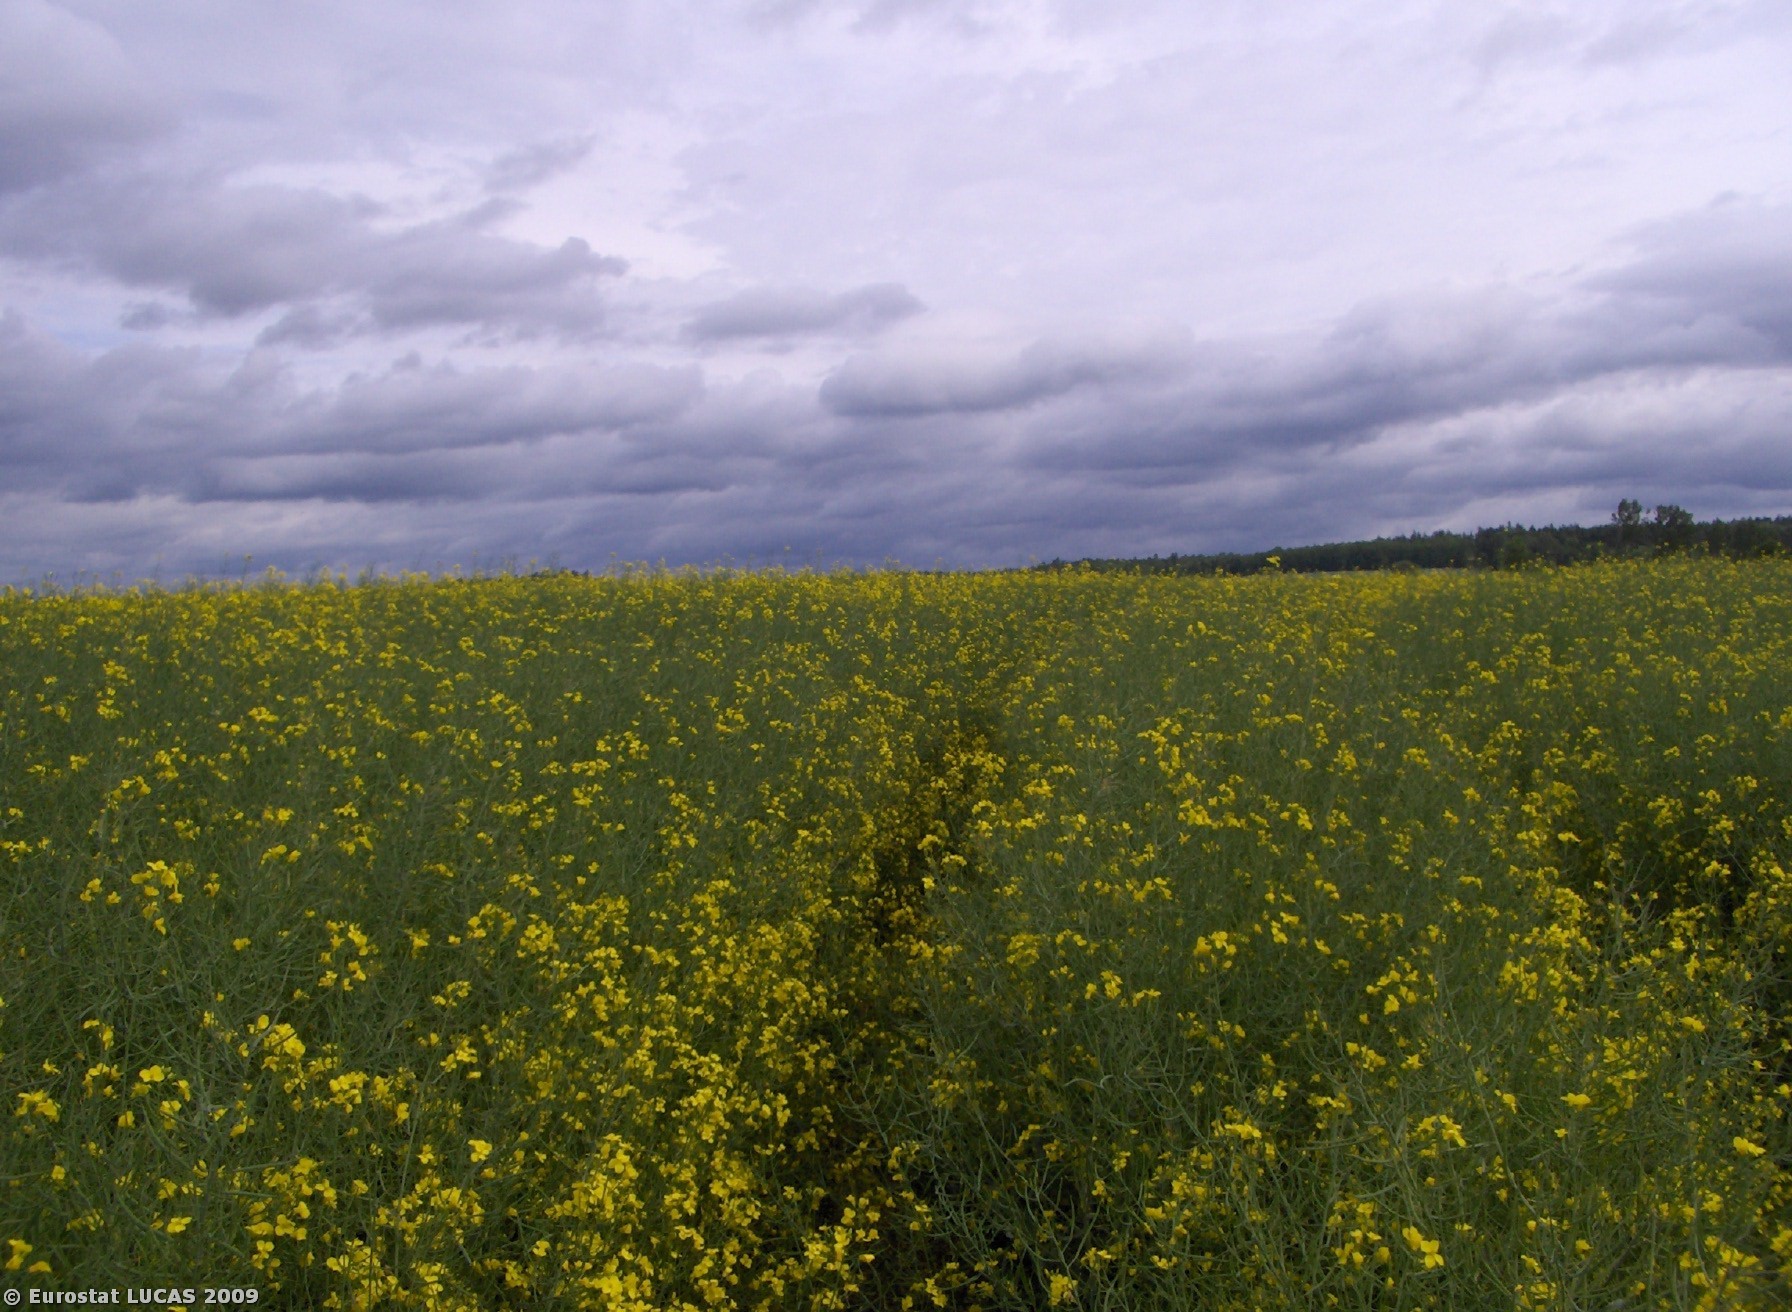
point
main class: Cropland
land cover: Rape and turnip rape
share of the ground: > 75 %
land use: Agriculture (excluding fallow land and kitchen gardens)
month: May
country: CZ
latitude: 49.3516
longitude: 14.1720
